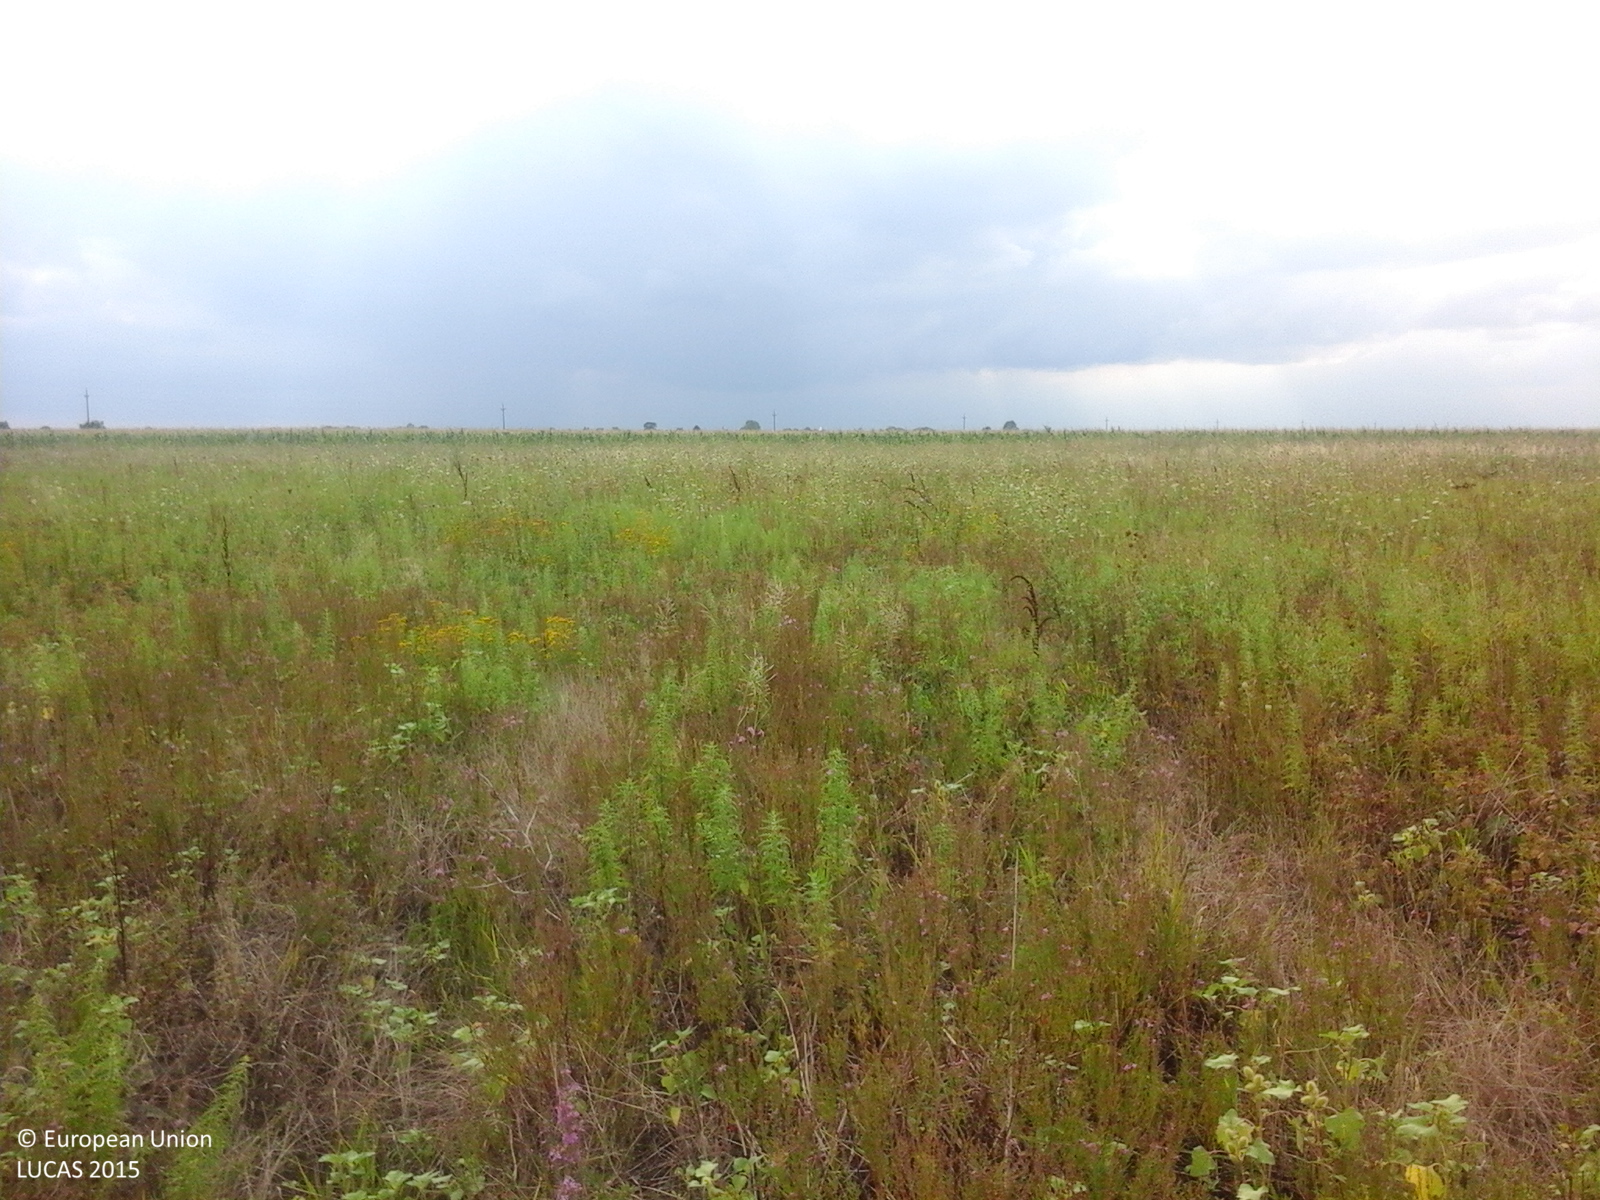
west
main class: Grassland
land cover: Spontaneously vegetated surfaces
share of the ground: > 75 %
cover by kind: herbaceous plants 100 %
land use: Agriculture (excluding fallow land and kitchen gardens)
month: August
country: RO
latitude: 45.6239
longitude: 21.4603
